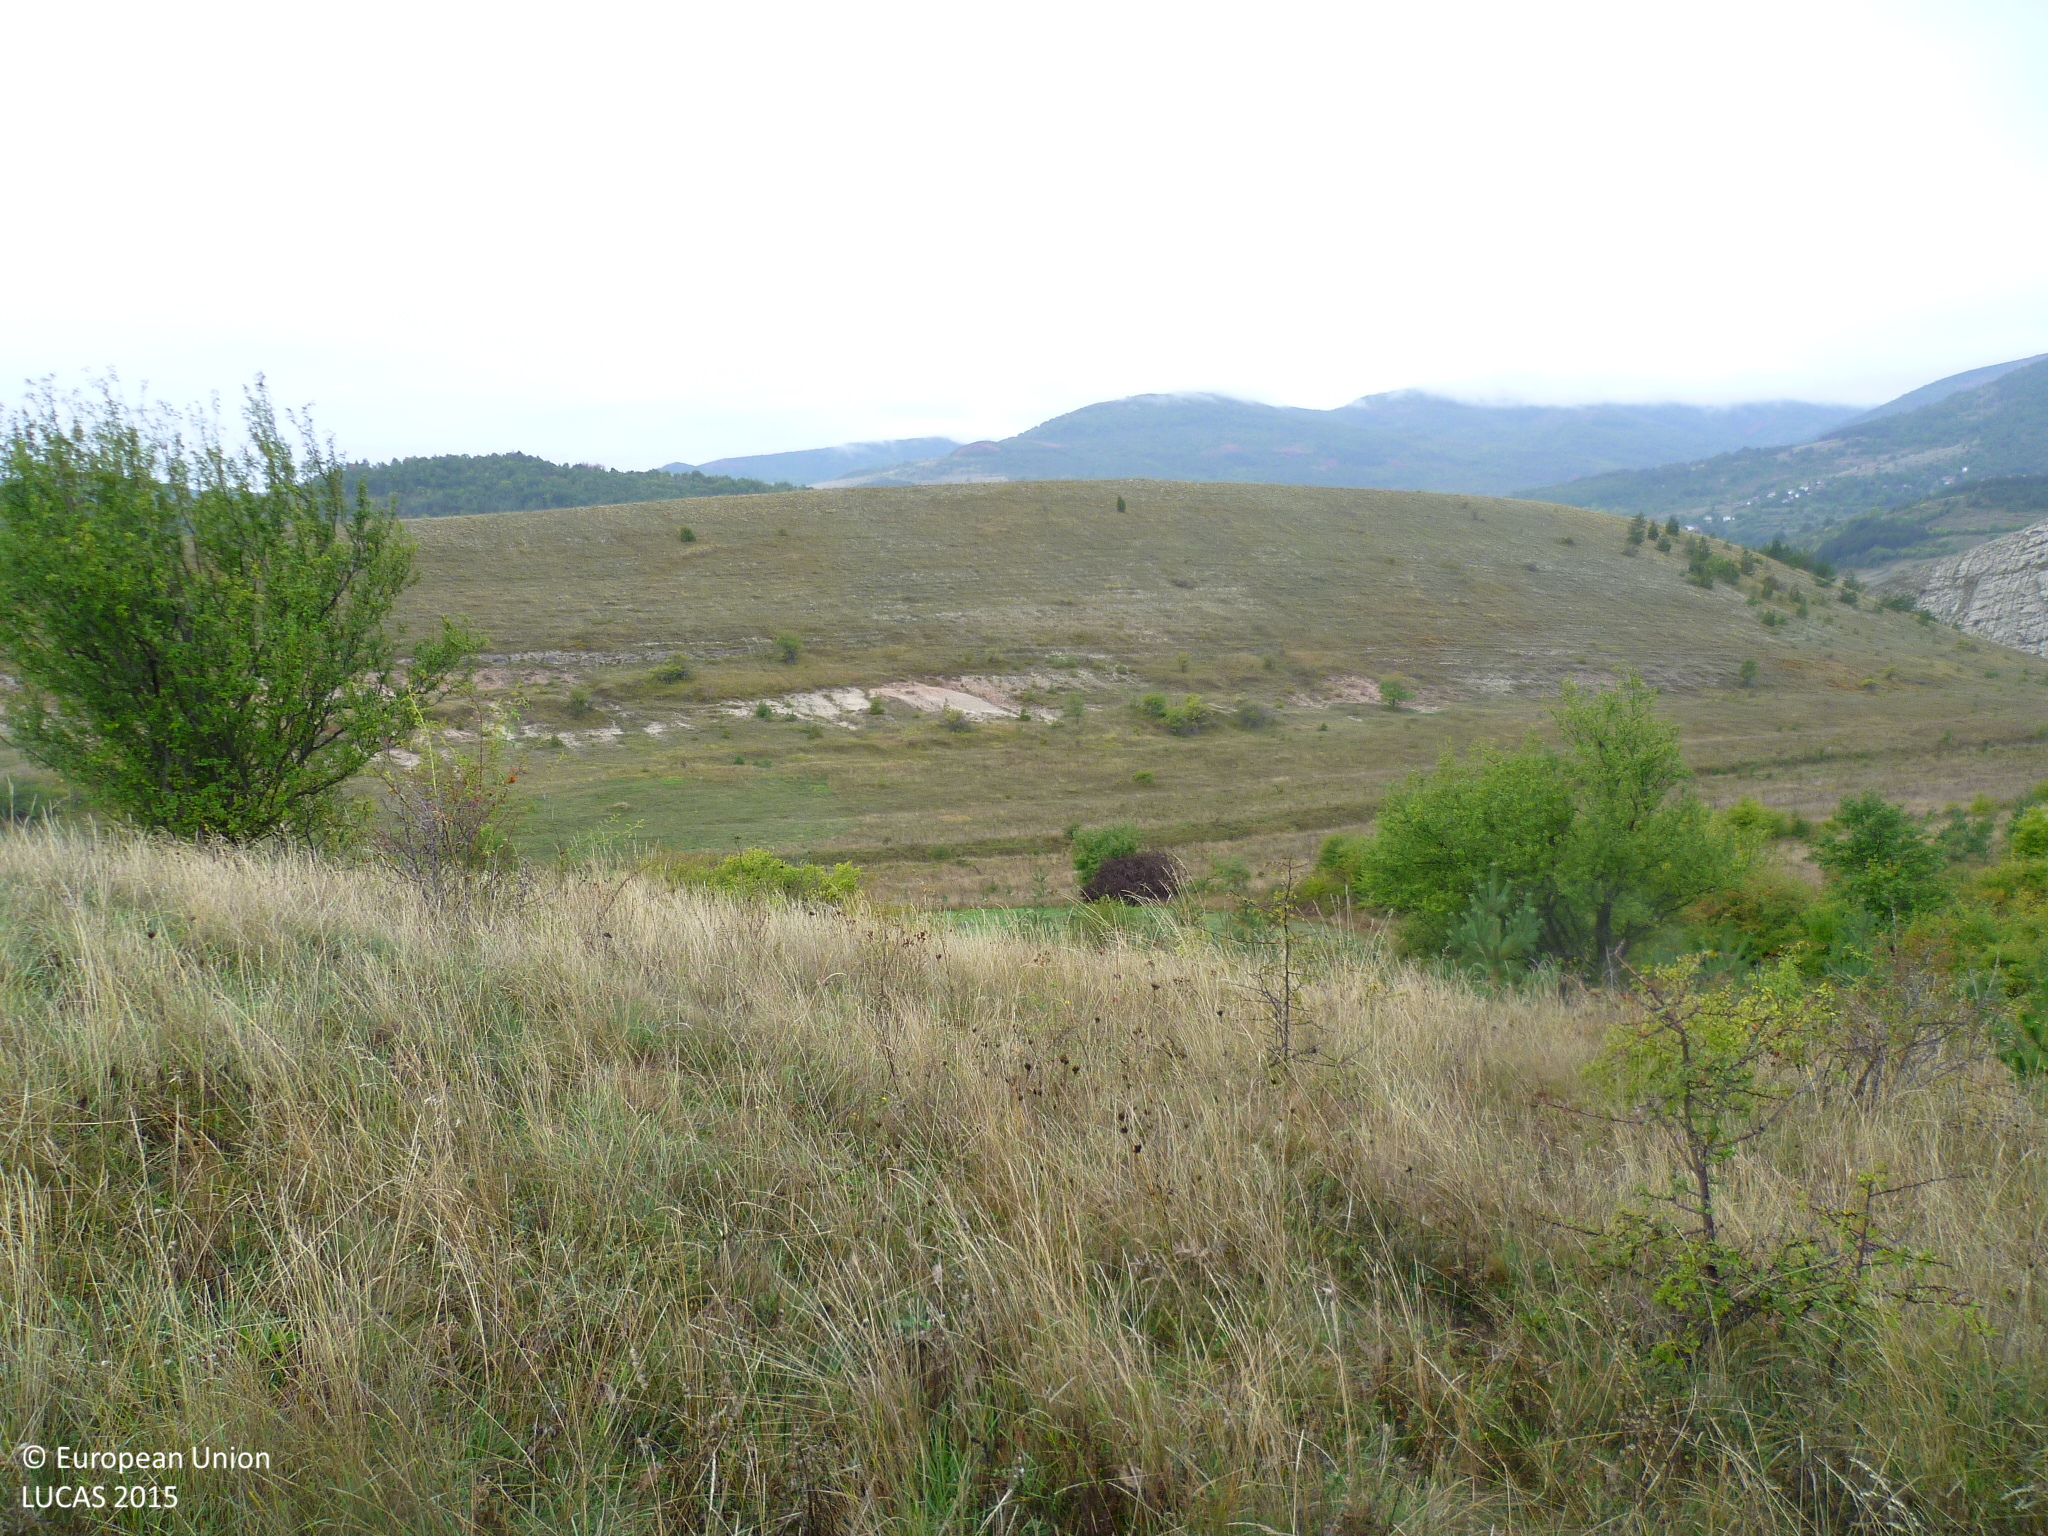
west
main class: Grassland
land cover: Grassland with sparse tree/shrub cover
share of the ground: > 75 %
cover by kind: herbaceous plants 90 %, broadleaved forest trees 5 %, shrubs 5 %
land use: Agriculture (excluding fallow land and kitchen gardens)
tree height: < 5 m
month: September
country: BG
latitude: 42.6838
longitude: 22.7555
